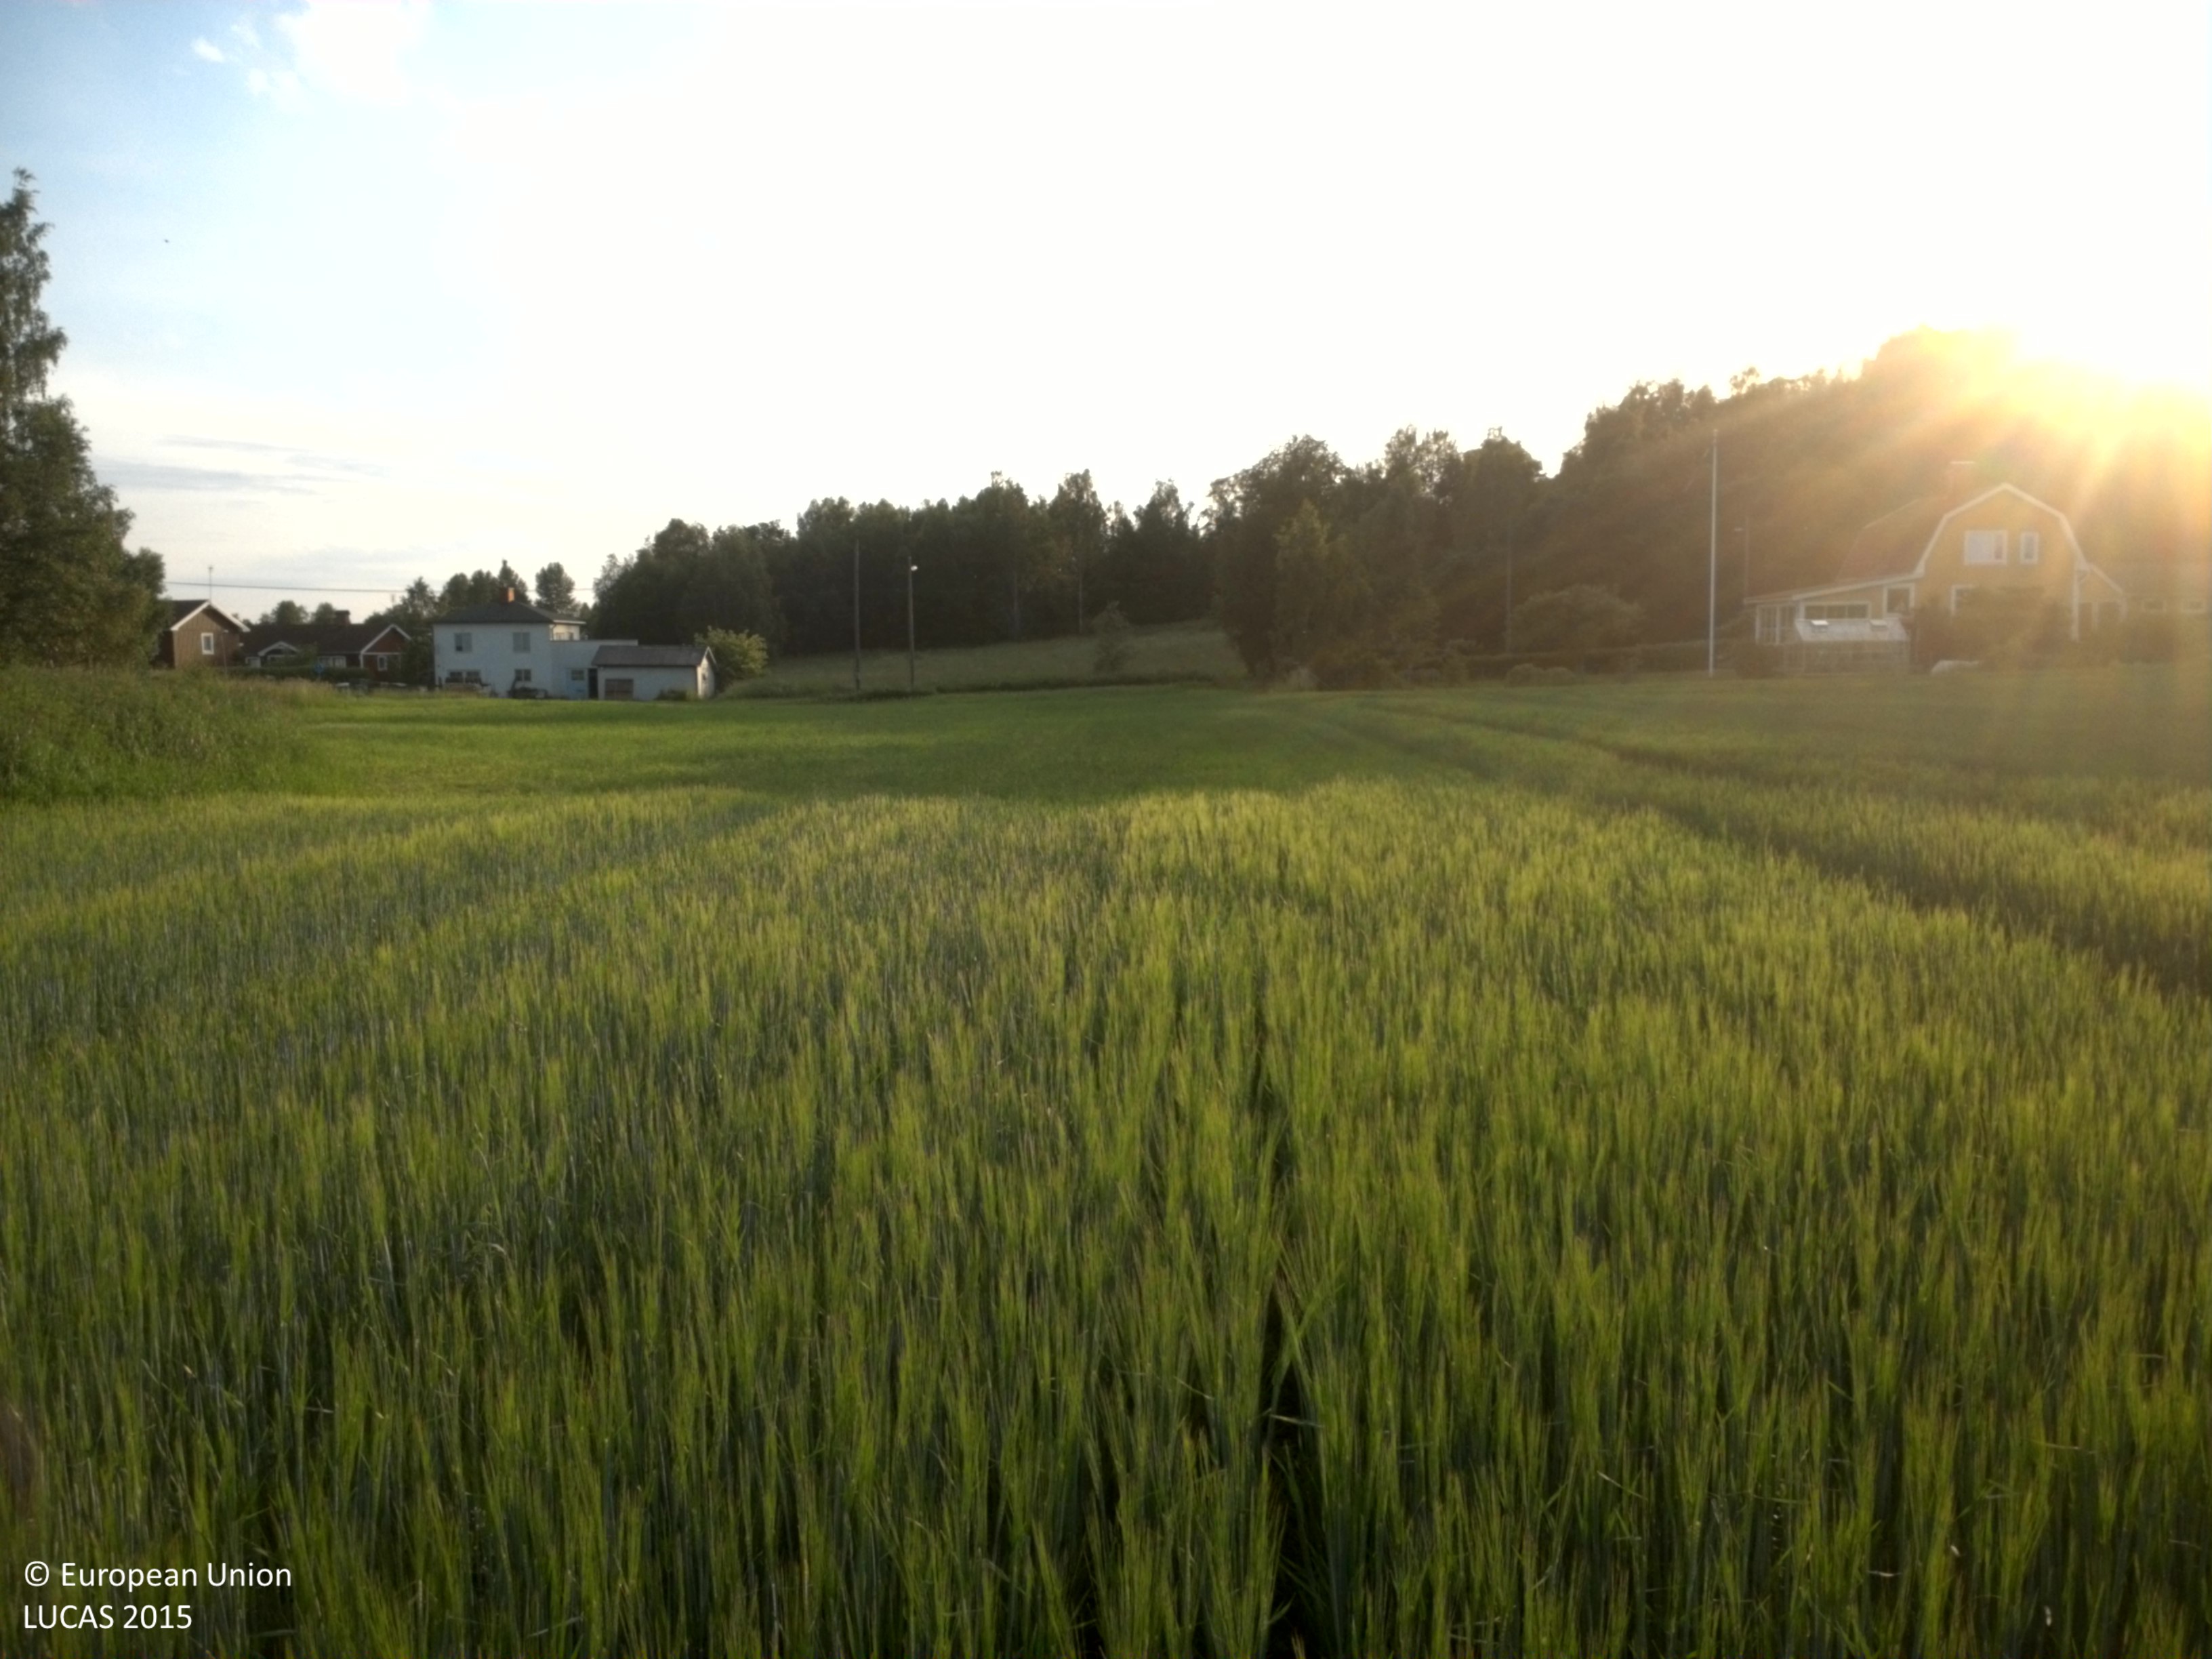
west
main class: Cropland
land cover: Barley
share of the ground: > 75 %
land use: Agriculture (excluding fallow land and kitchen gardens)
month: July
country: SE
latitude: 59.3311
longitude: 14.5789
